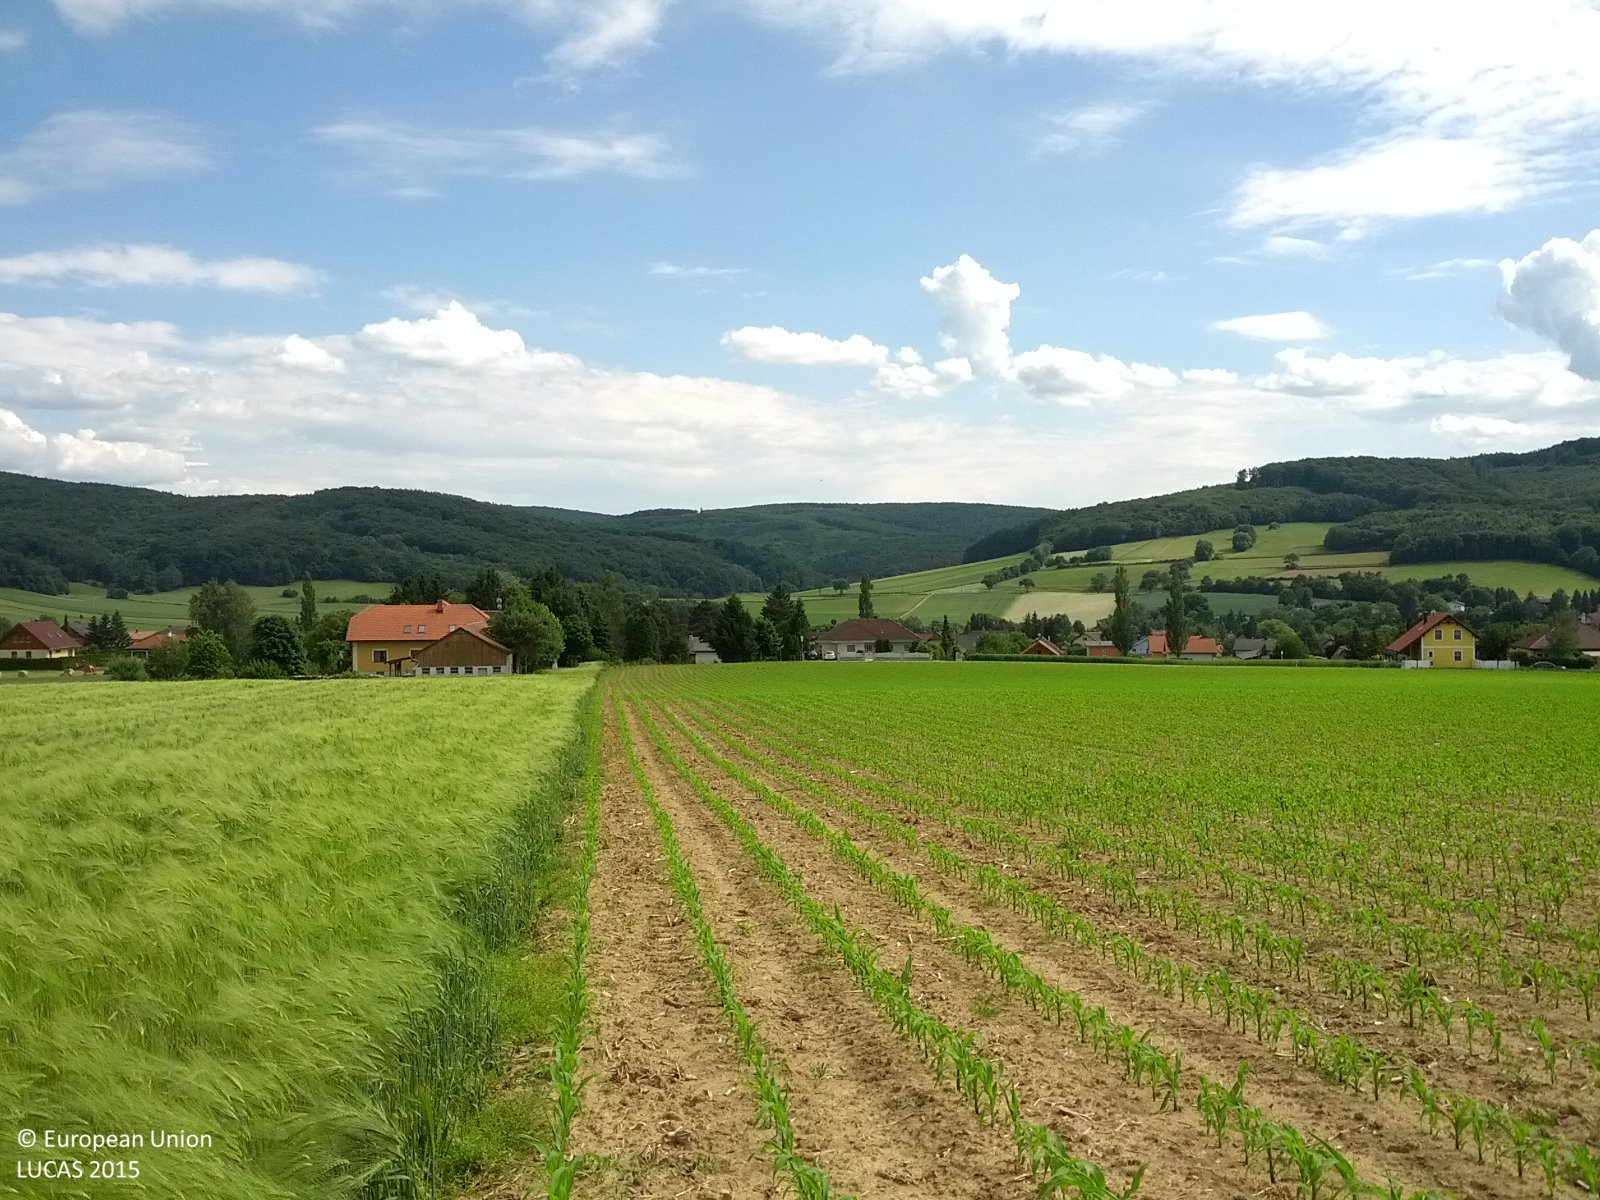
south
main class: Cropland
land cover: Barley
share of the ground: > 75 %
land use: Agriculture (excluding fallow land and kitchen gardens)
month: June
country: AT
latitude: 48.2558
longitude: 16.0516
